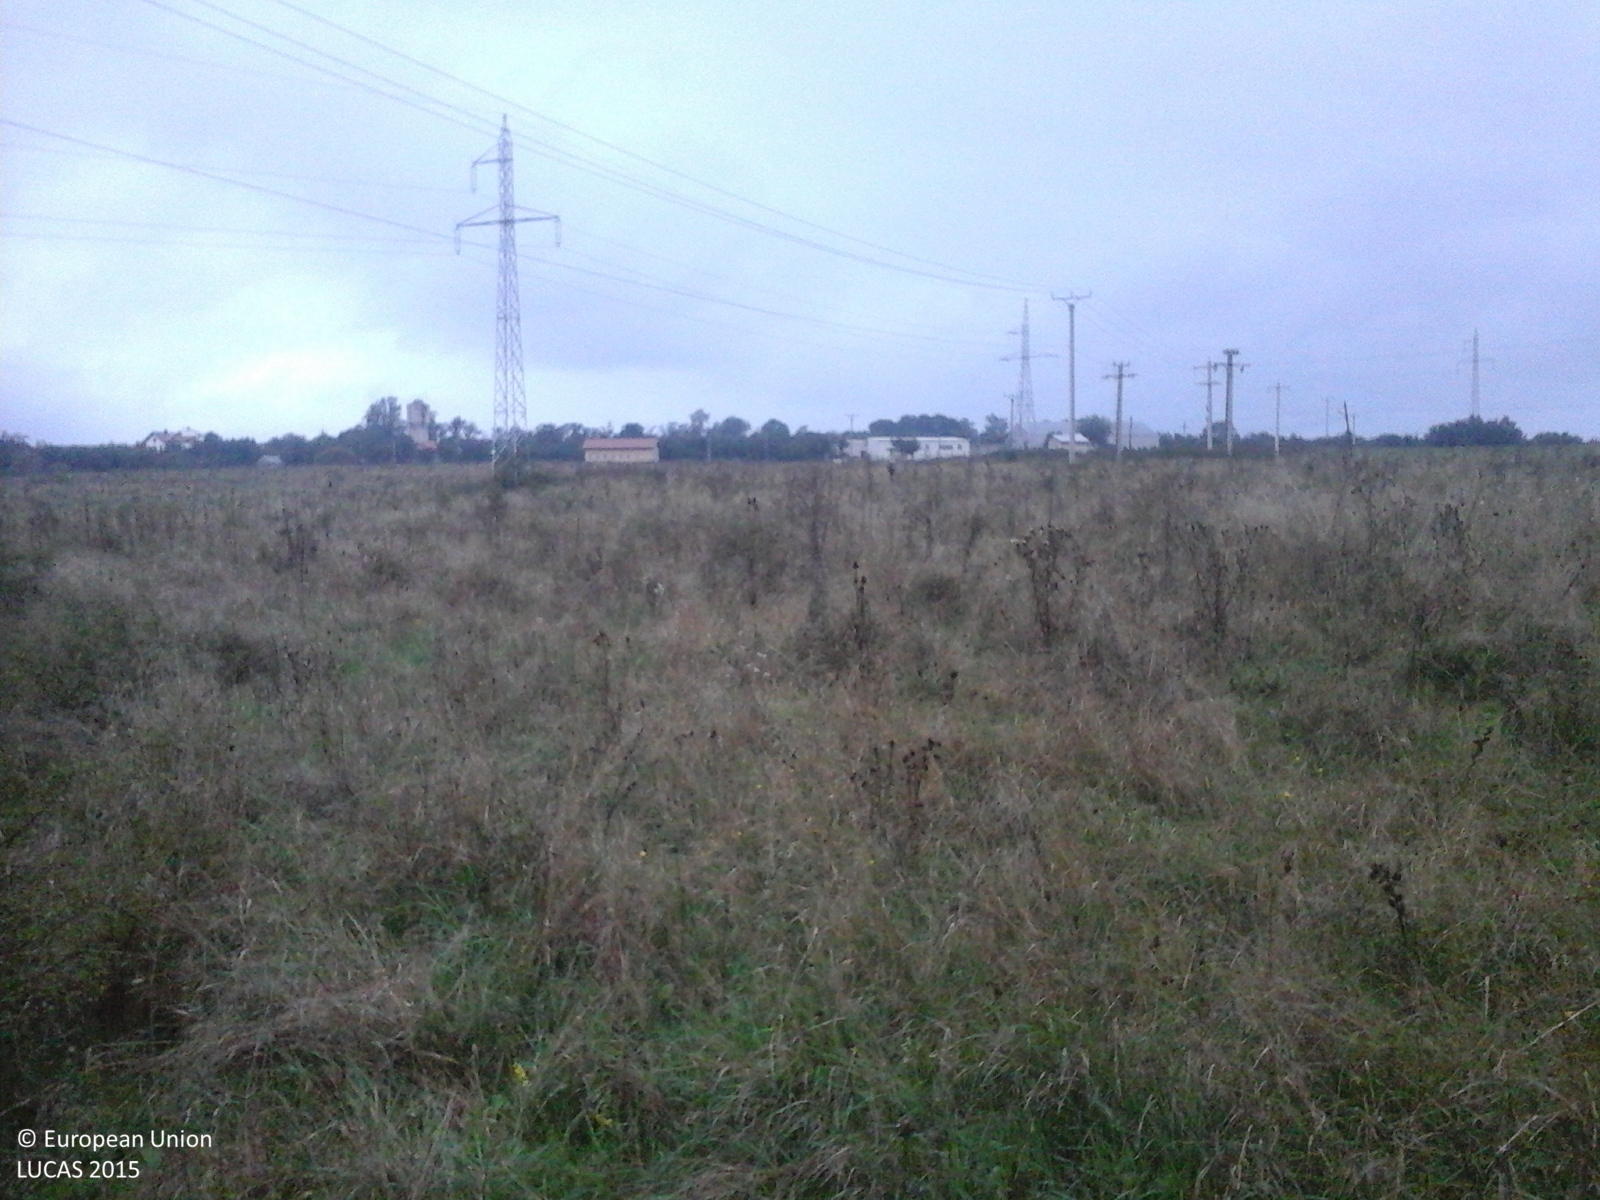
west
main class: Grassland
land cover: Grassland with sparse tree/shrub cover
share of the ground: > 75 %
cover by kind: herbaceous plants 85 %, shrubs 10 %, broadleaved forest trees 5 %
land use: Fallow land
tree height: < 5 m
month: September
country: RO
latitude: 45.8520
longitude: 23.8099
